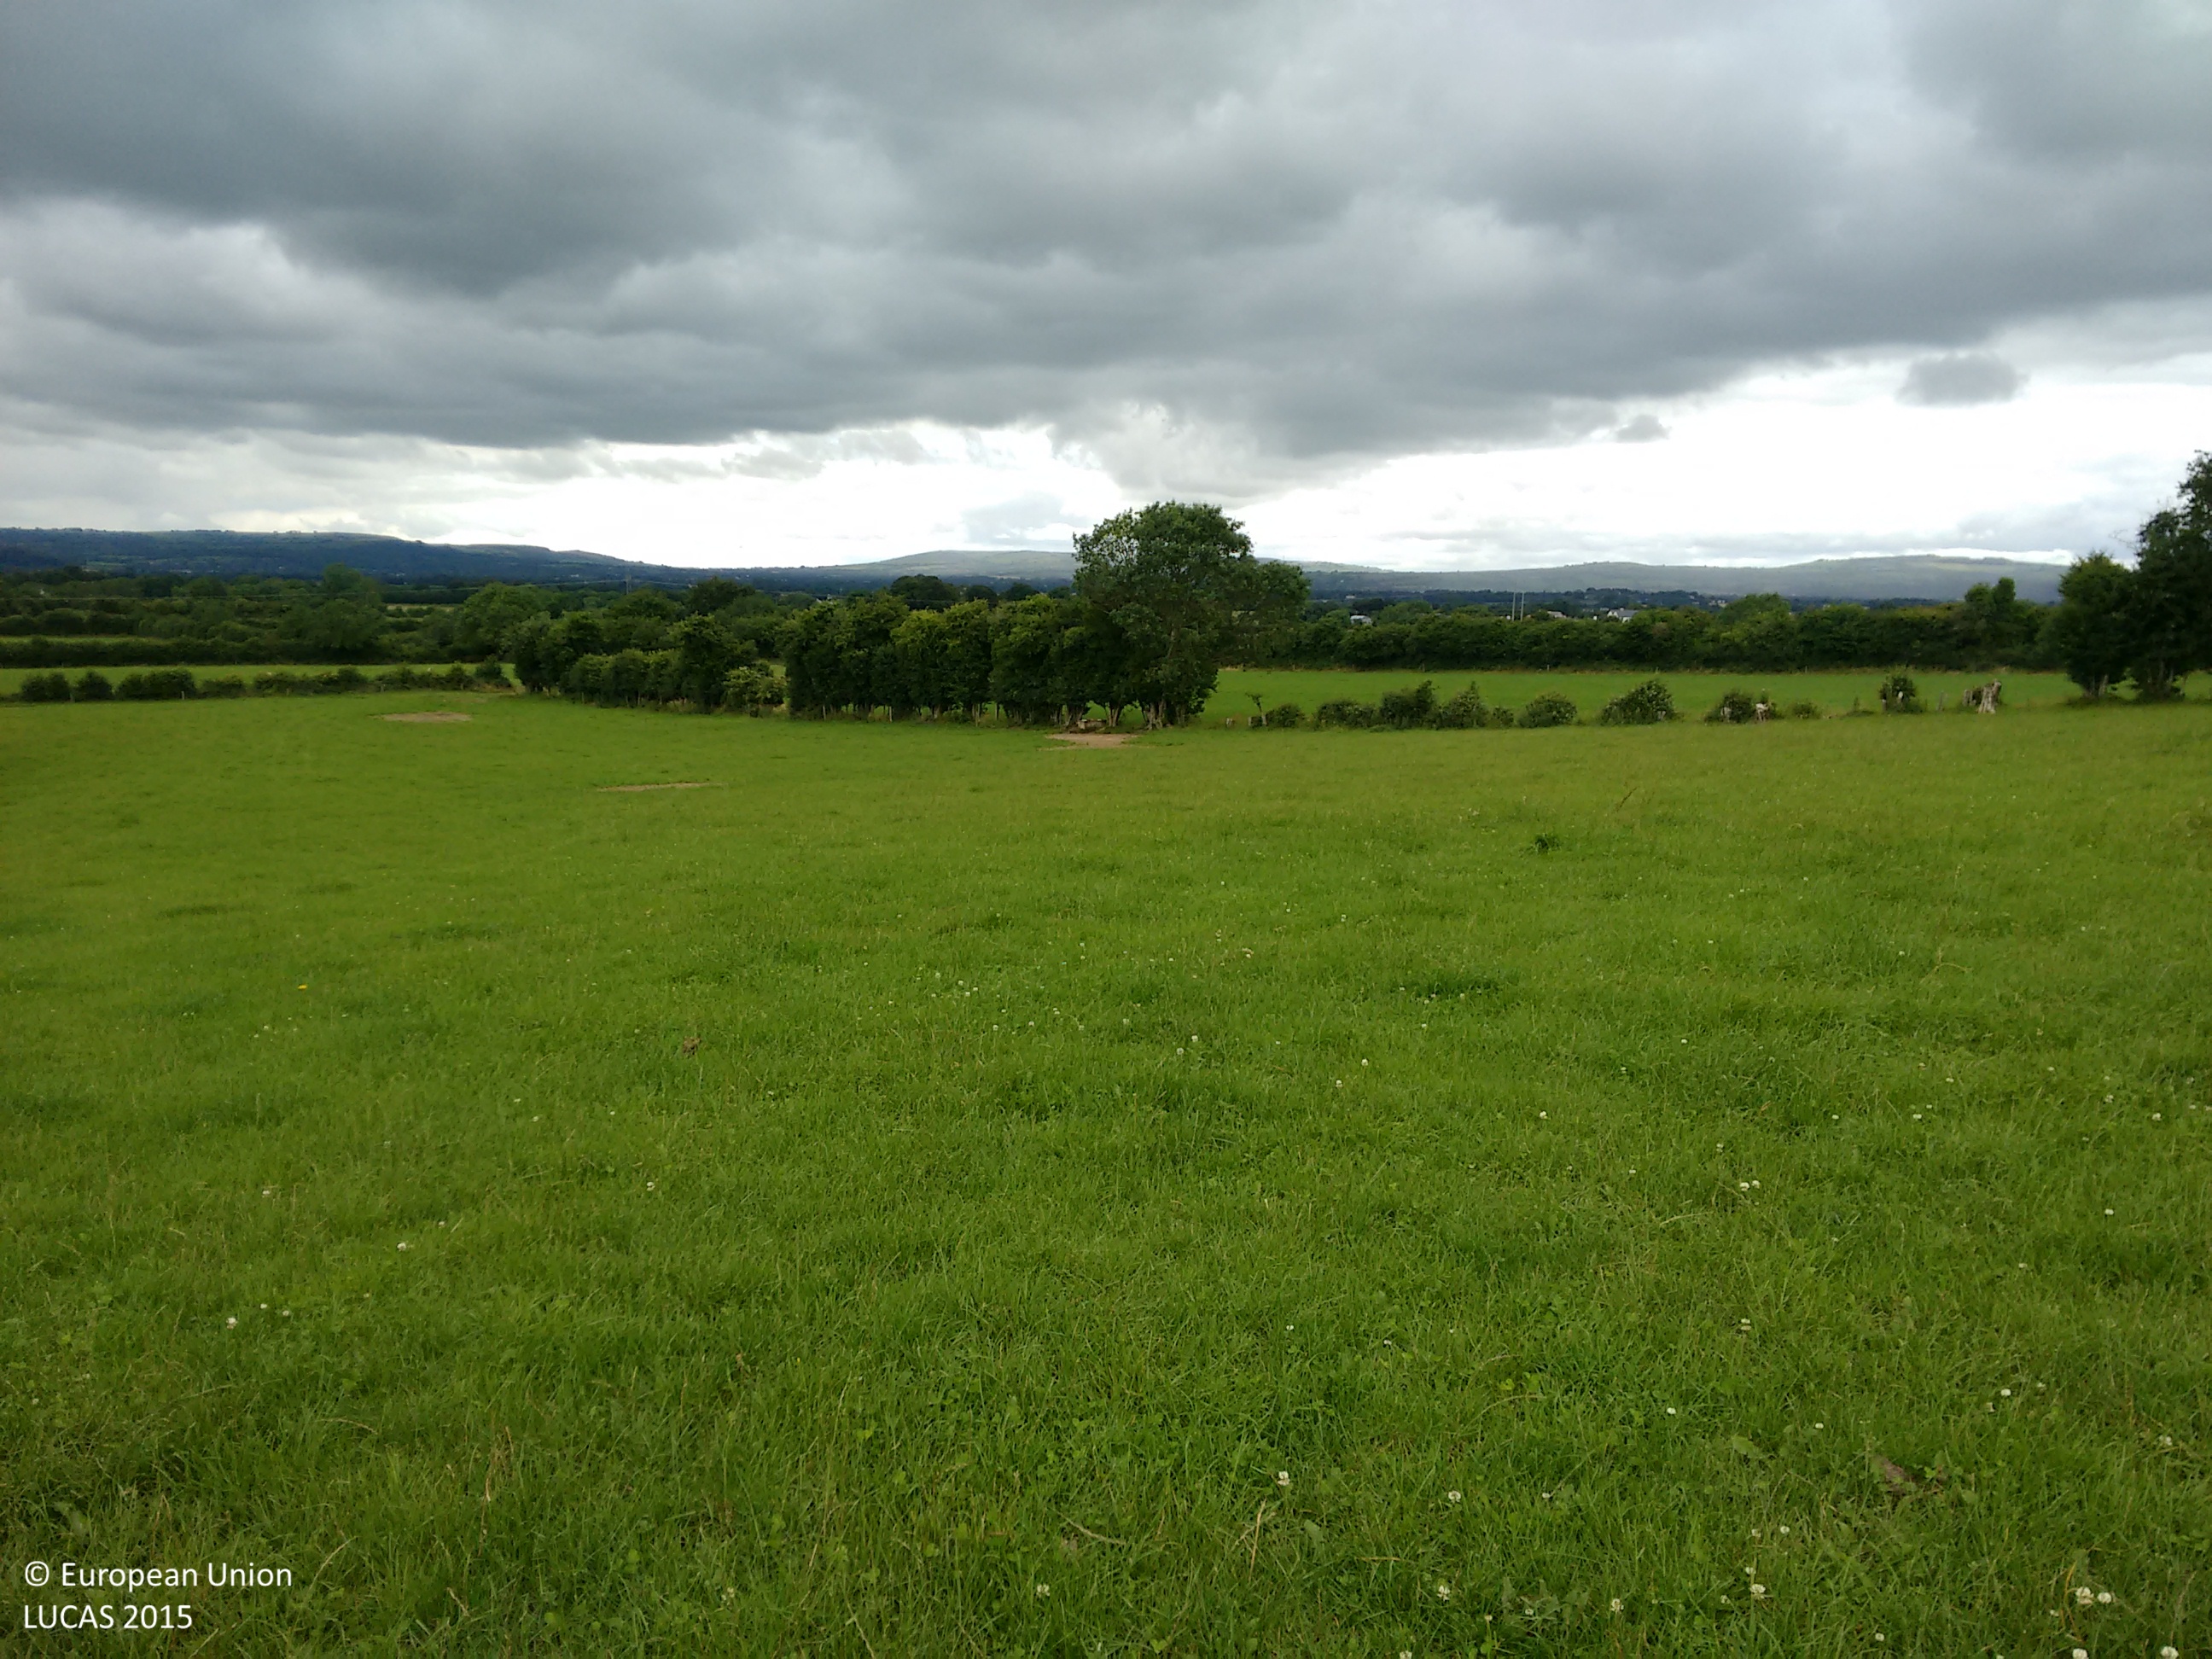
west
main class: Grassland
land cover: Grassland without tree/shrub cover
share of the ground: > 75 %
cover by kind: herbaceous plants 100 %
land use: Agriculture (excluding fallow land and kitchen gardens)
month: July
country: IE
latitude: 52.7512
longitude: -7.2936
